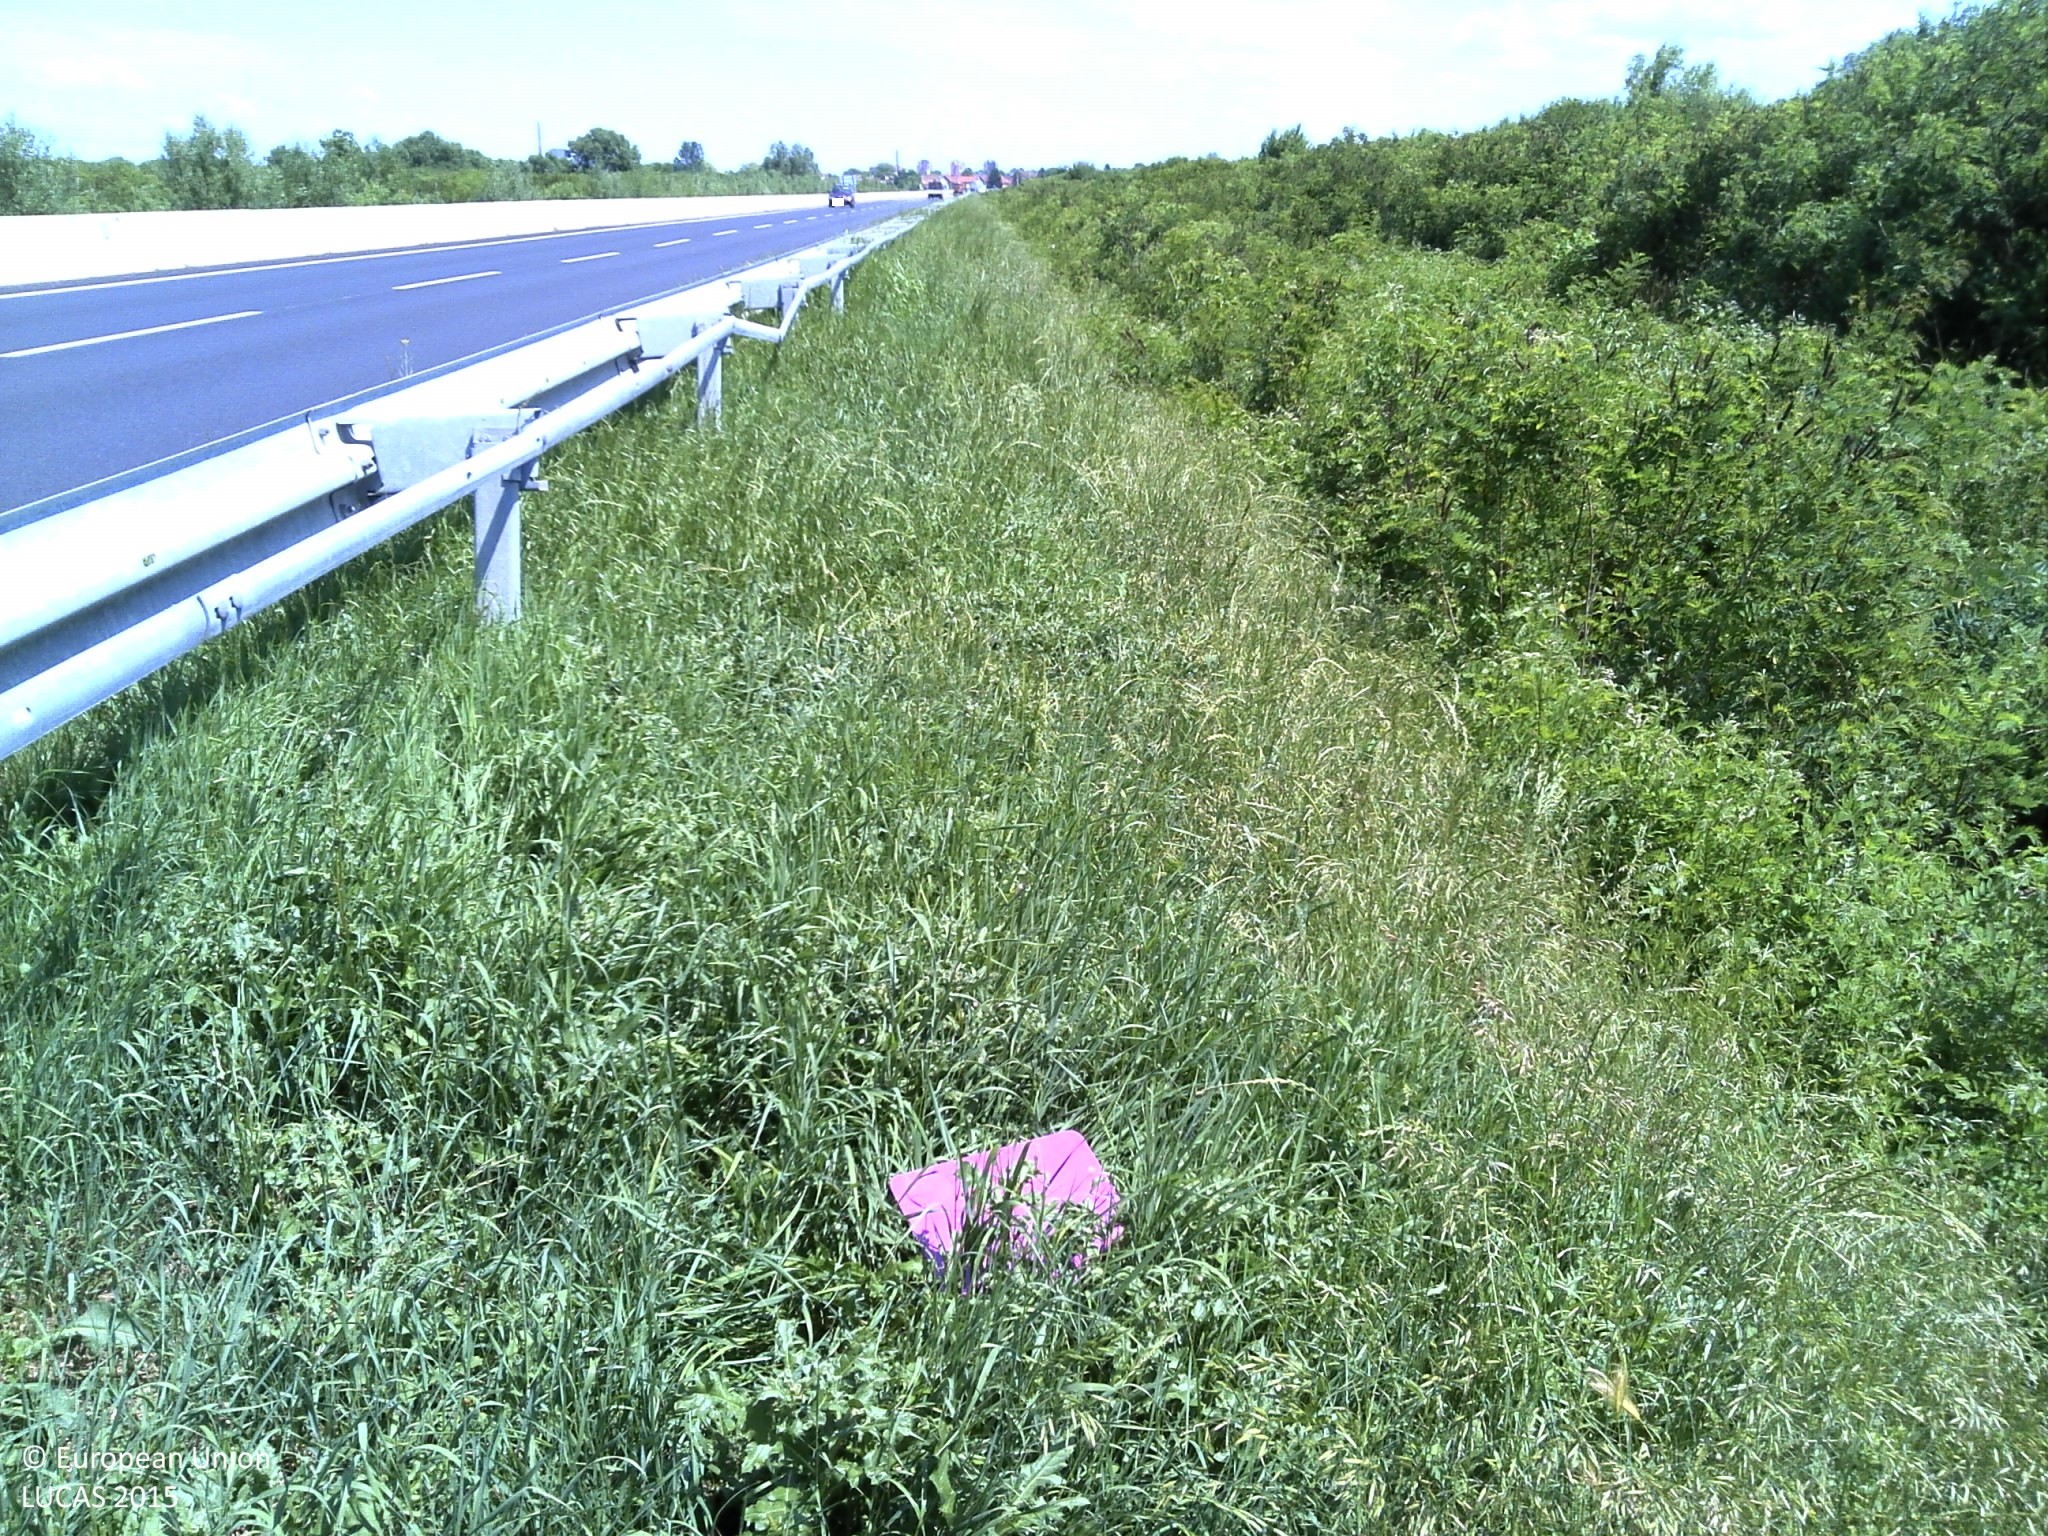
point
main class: Grassland
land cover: Spontaneously vegetated surfaces
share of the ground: > 75 %
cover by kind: herbaceous plants 100 %
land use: Fallow land
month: June
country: HR
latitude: 45.1659
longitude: 17.9794
